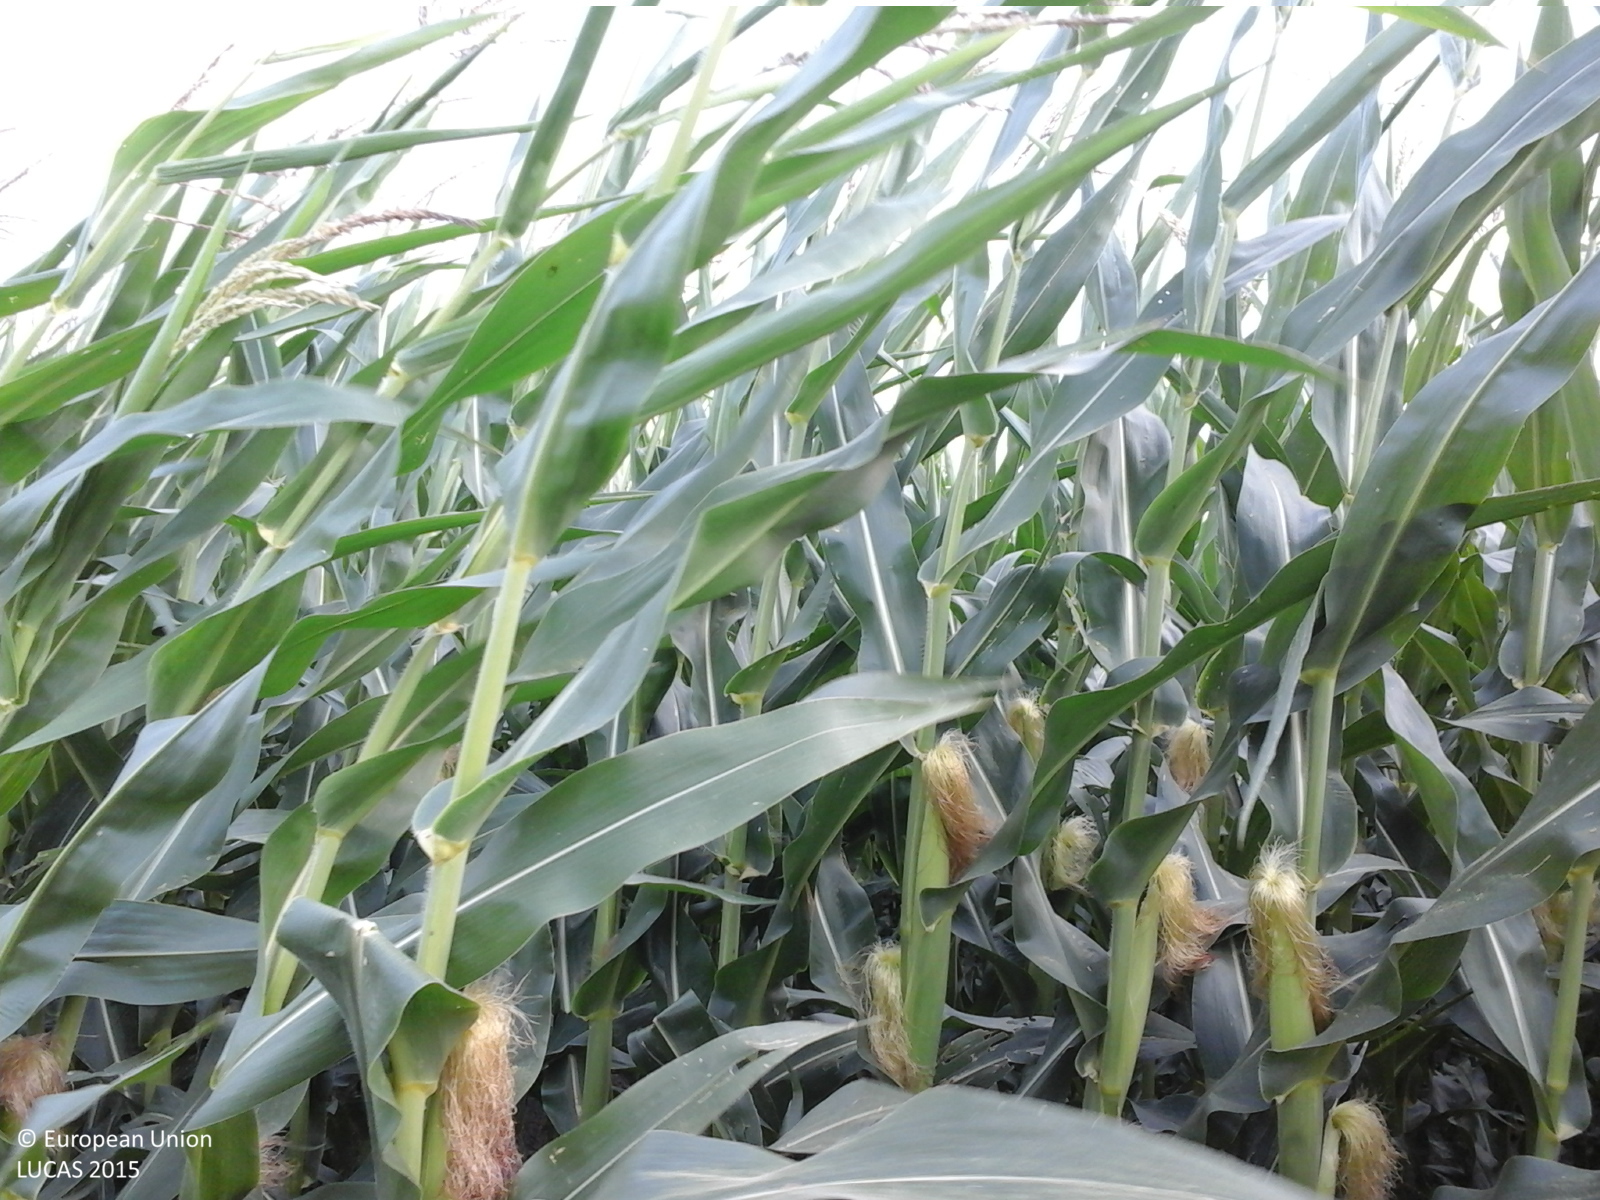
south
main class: Cropland
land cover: Maize
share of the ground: > 75 %
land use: Agriculture (excluding fallow land and kitchen gardens)
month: July
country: RO
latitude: 43.7270
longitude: 25.2613
